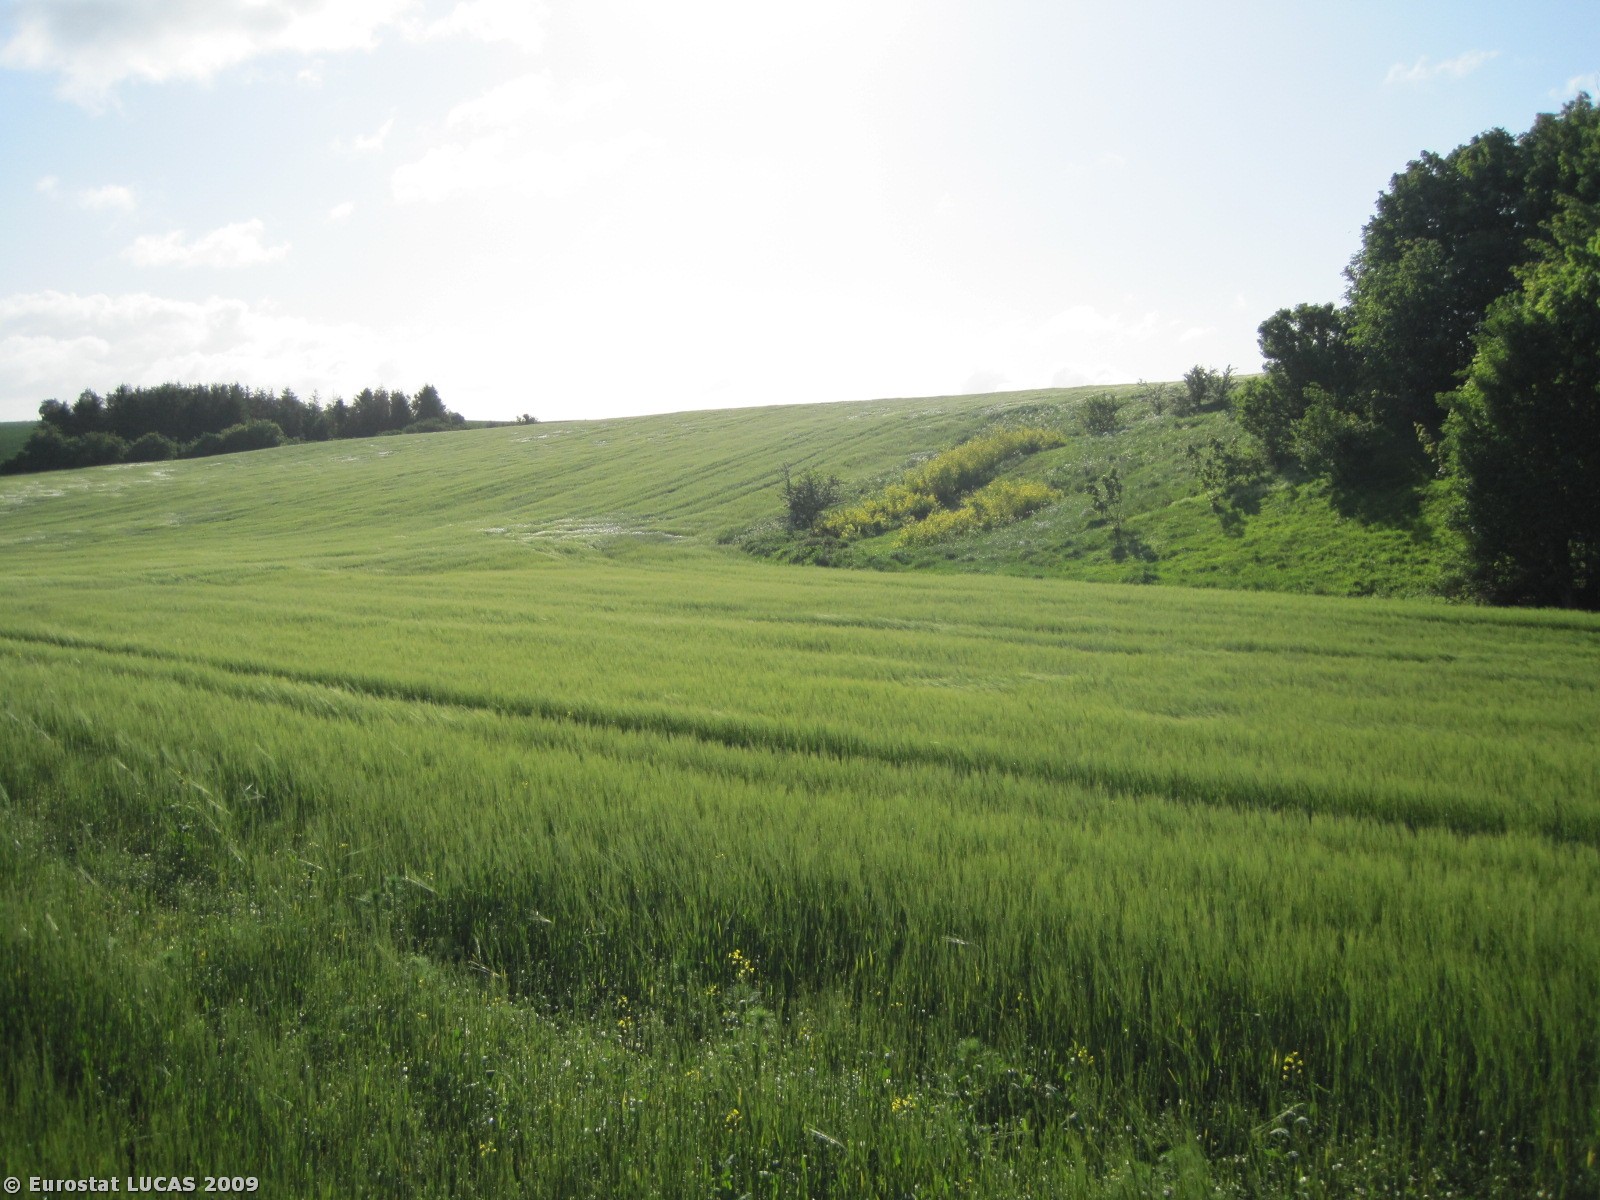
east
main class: Woodland
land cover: Broadleaved woodland
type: mesophytic deciduous forest
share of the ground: > 75 %
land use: Unused
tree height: > 5 m
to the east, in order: Broadleaved woodland; Grassland without tree/shrub cover; Barley; Grass margins; Grassland without tree/shrub cover; Shrubland without tree cover; Grass margins; Barley
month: May
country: DK
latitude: 56.5652
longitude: 10.1138
